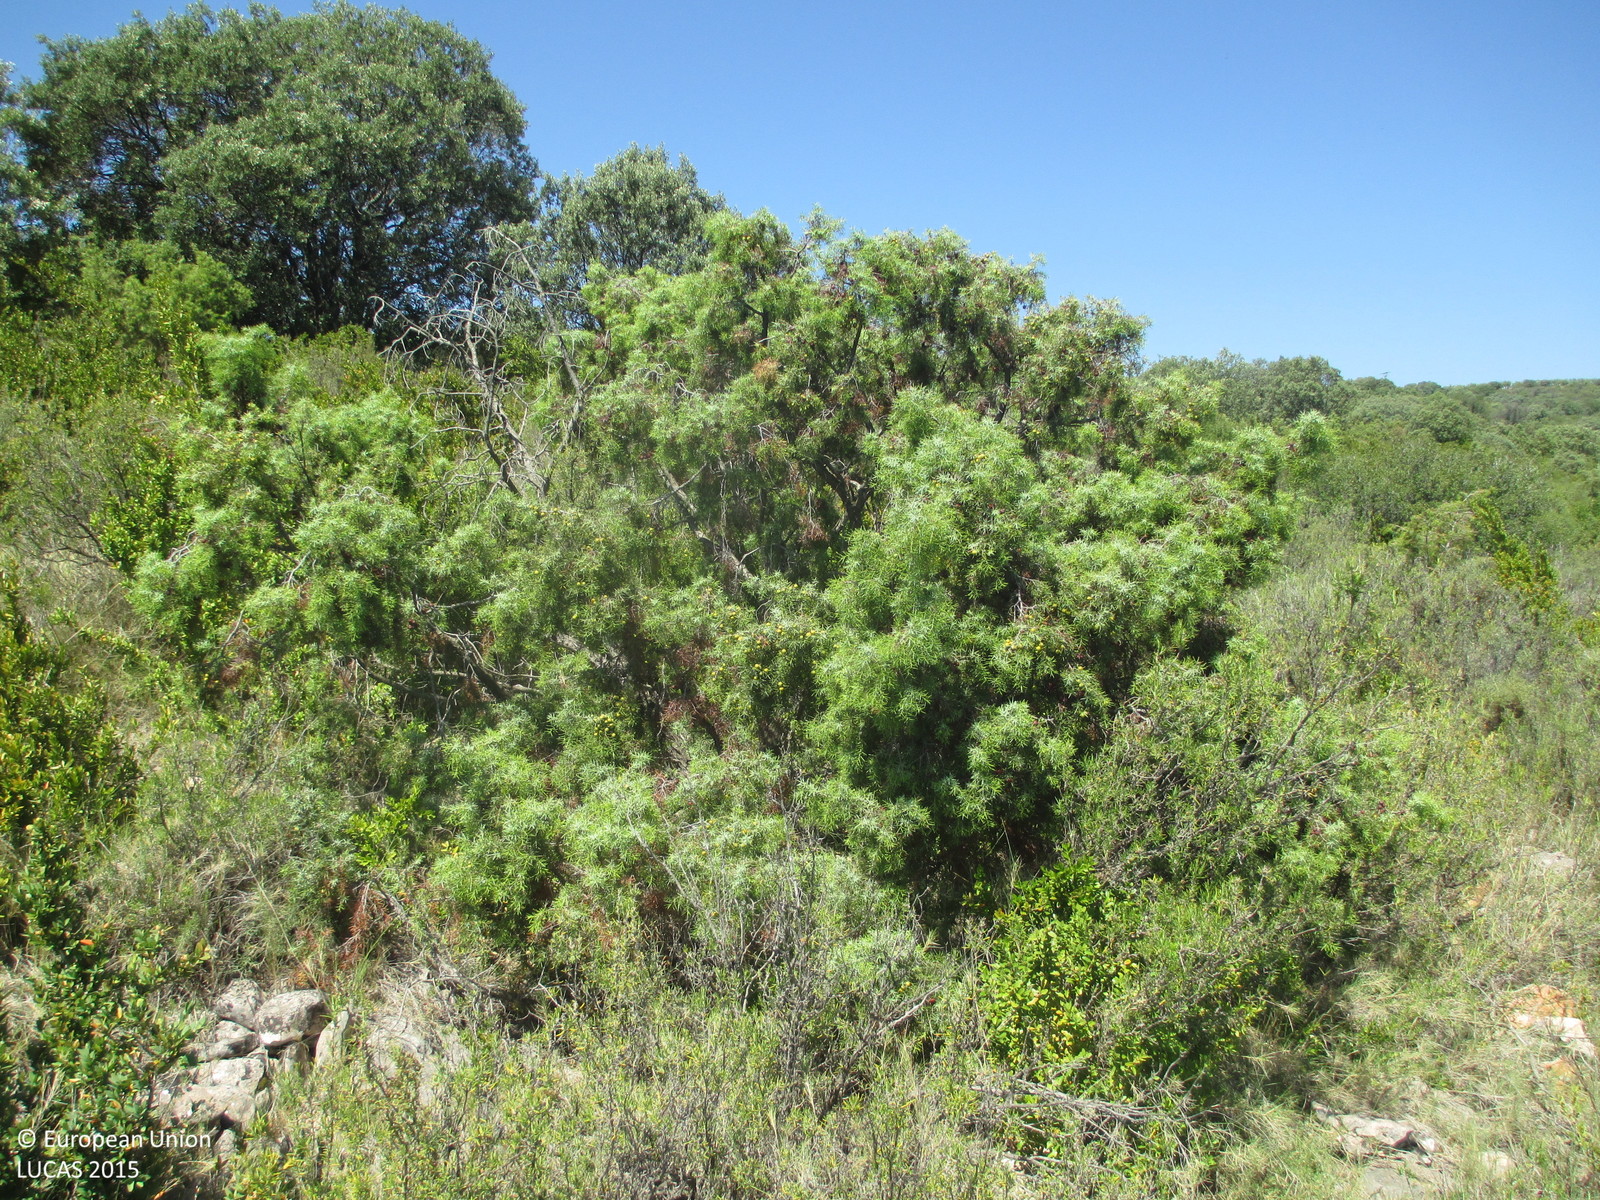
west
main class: Shrubland
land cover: Shrubland without tree cover
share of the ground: > 75 %
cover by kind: shrubs 95 %, herbaceous plants 5 %
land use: Semi-natural and natural areas not in use
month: June
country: ES
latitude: 42.1778
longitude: 0.0163
